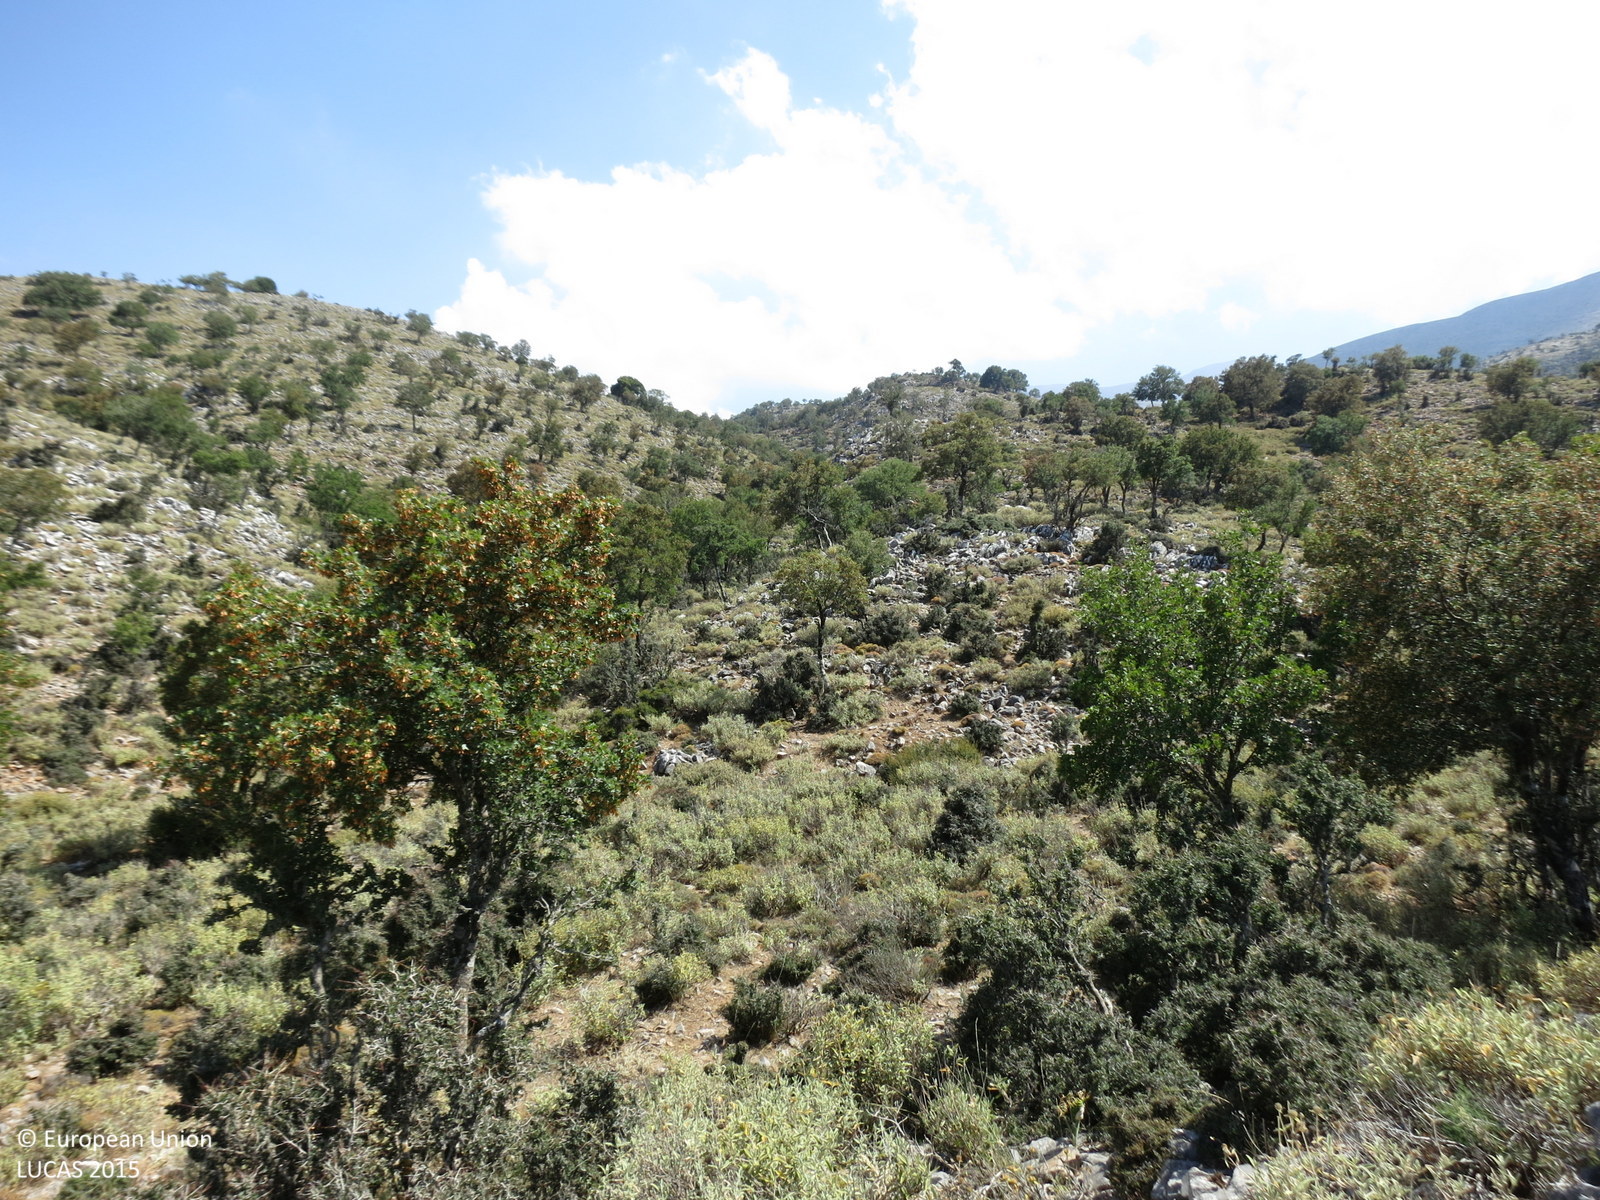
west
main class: Shrubland
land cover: Shrubland with sparse tree cover
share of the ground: 50 - 75 %
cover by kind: shrubs 55 %, unconsolidated bare surface 40 %, broadleaved forest trees 5 %
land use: Agriculture (excluding fallow land and kitchen gardens)
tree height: < 5 m
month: July
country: GR
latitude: 35.2753
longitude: 24.7971
